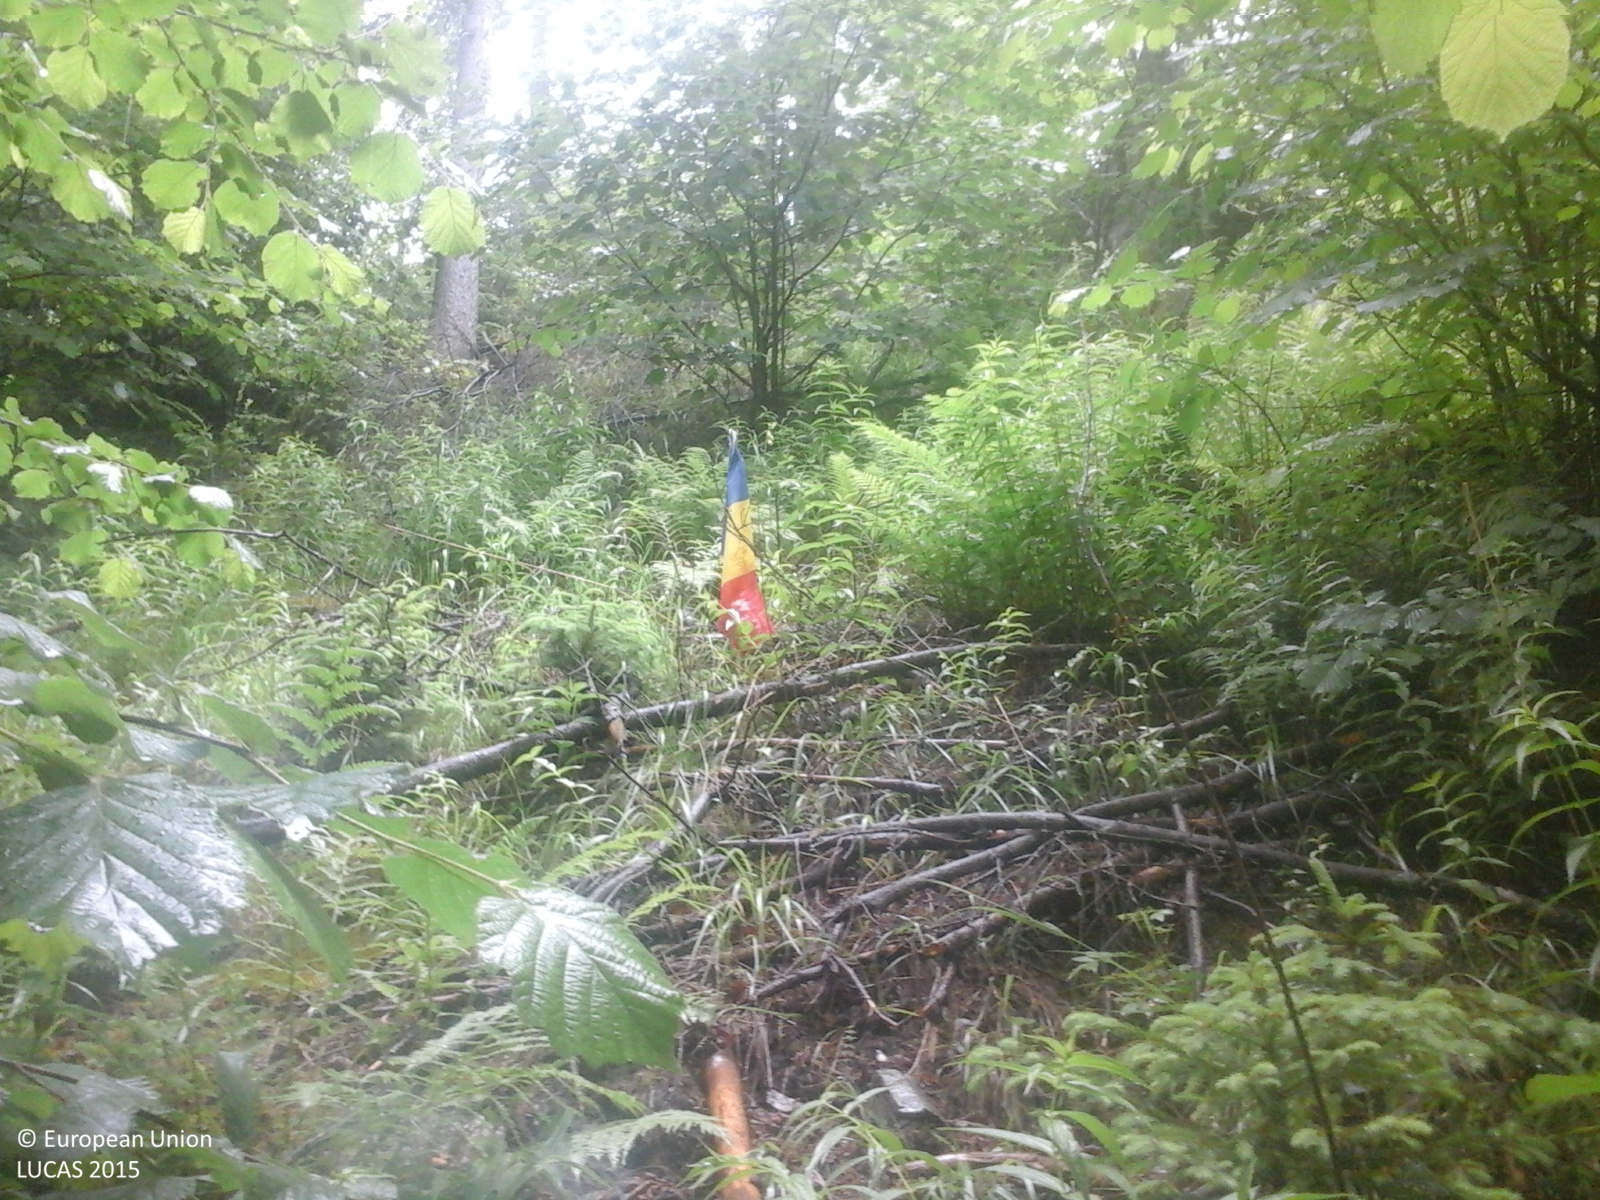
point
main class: Woodland
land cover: Broadleaved woodland
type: beech forest
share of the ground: > 75 %
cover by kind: broadleaved forest trees 90 %, shrubs 5 %, herbaceous plants 5 %
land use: Forestry
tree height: > 5 m
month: June
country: RO
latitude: 47.3399
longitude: 25.6161
